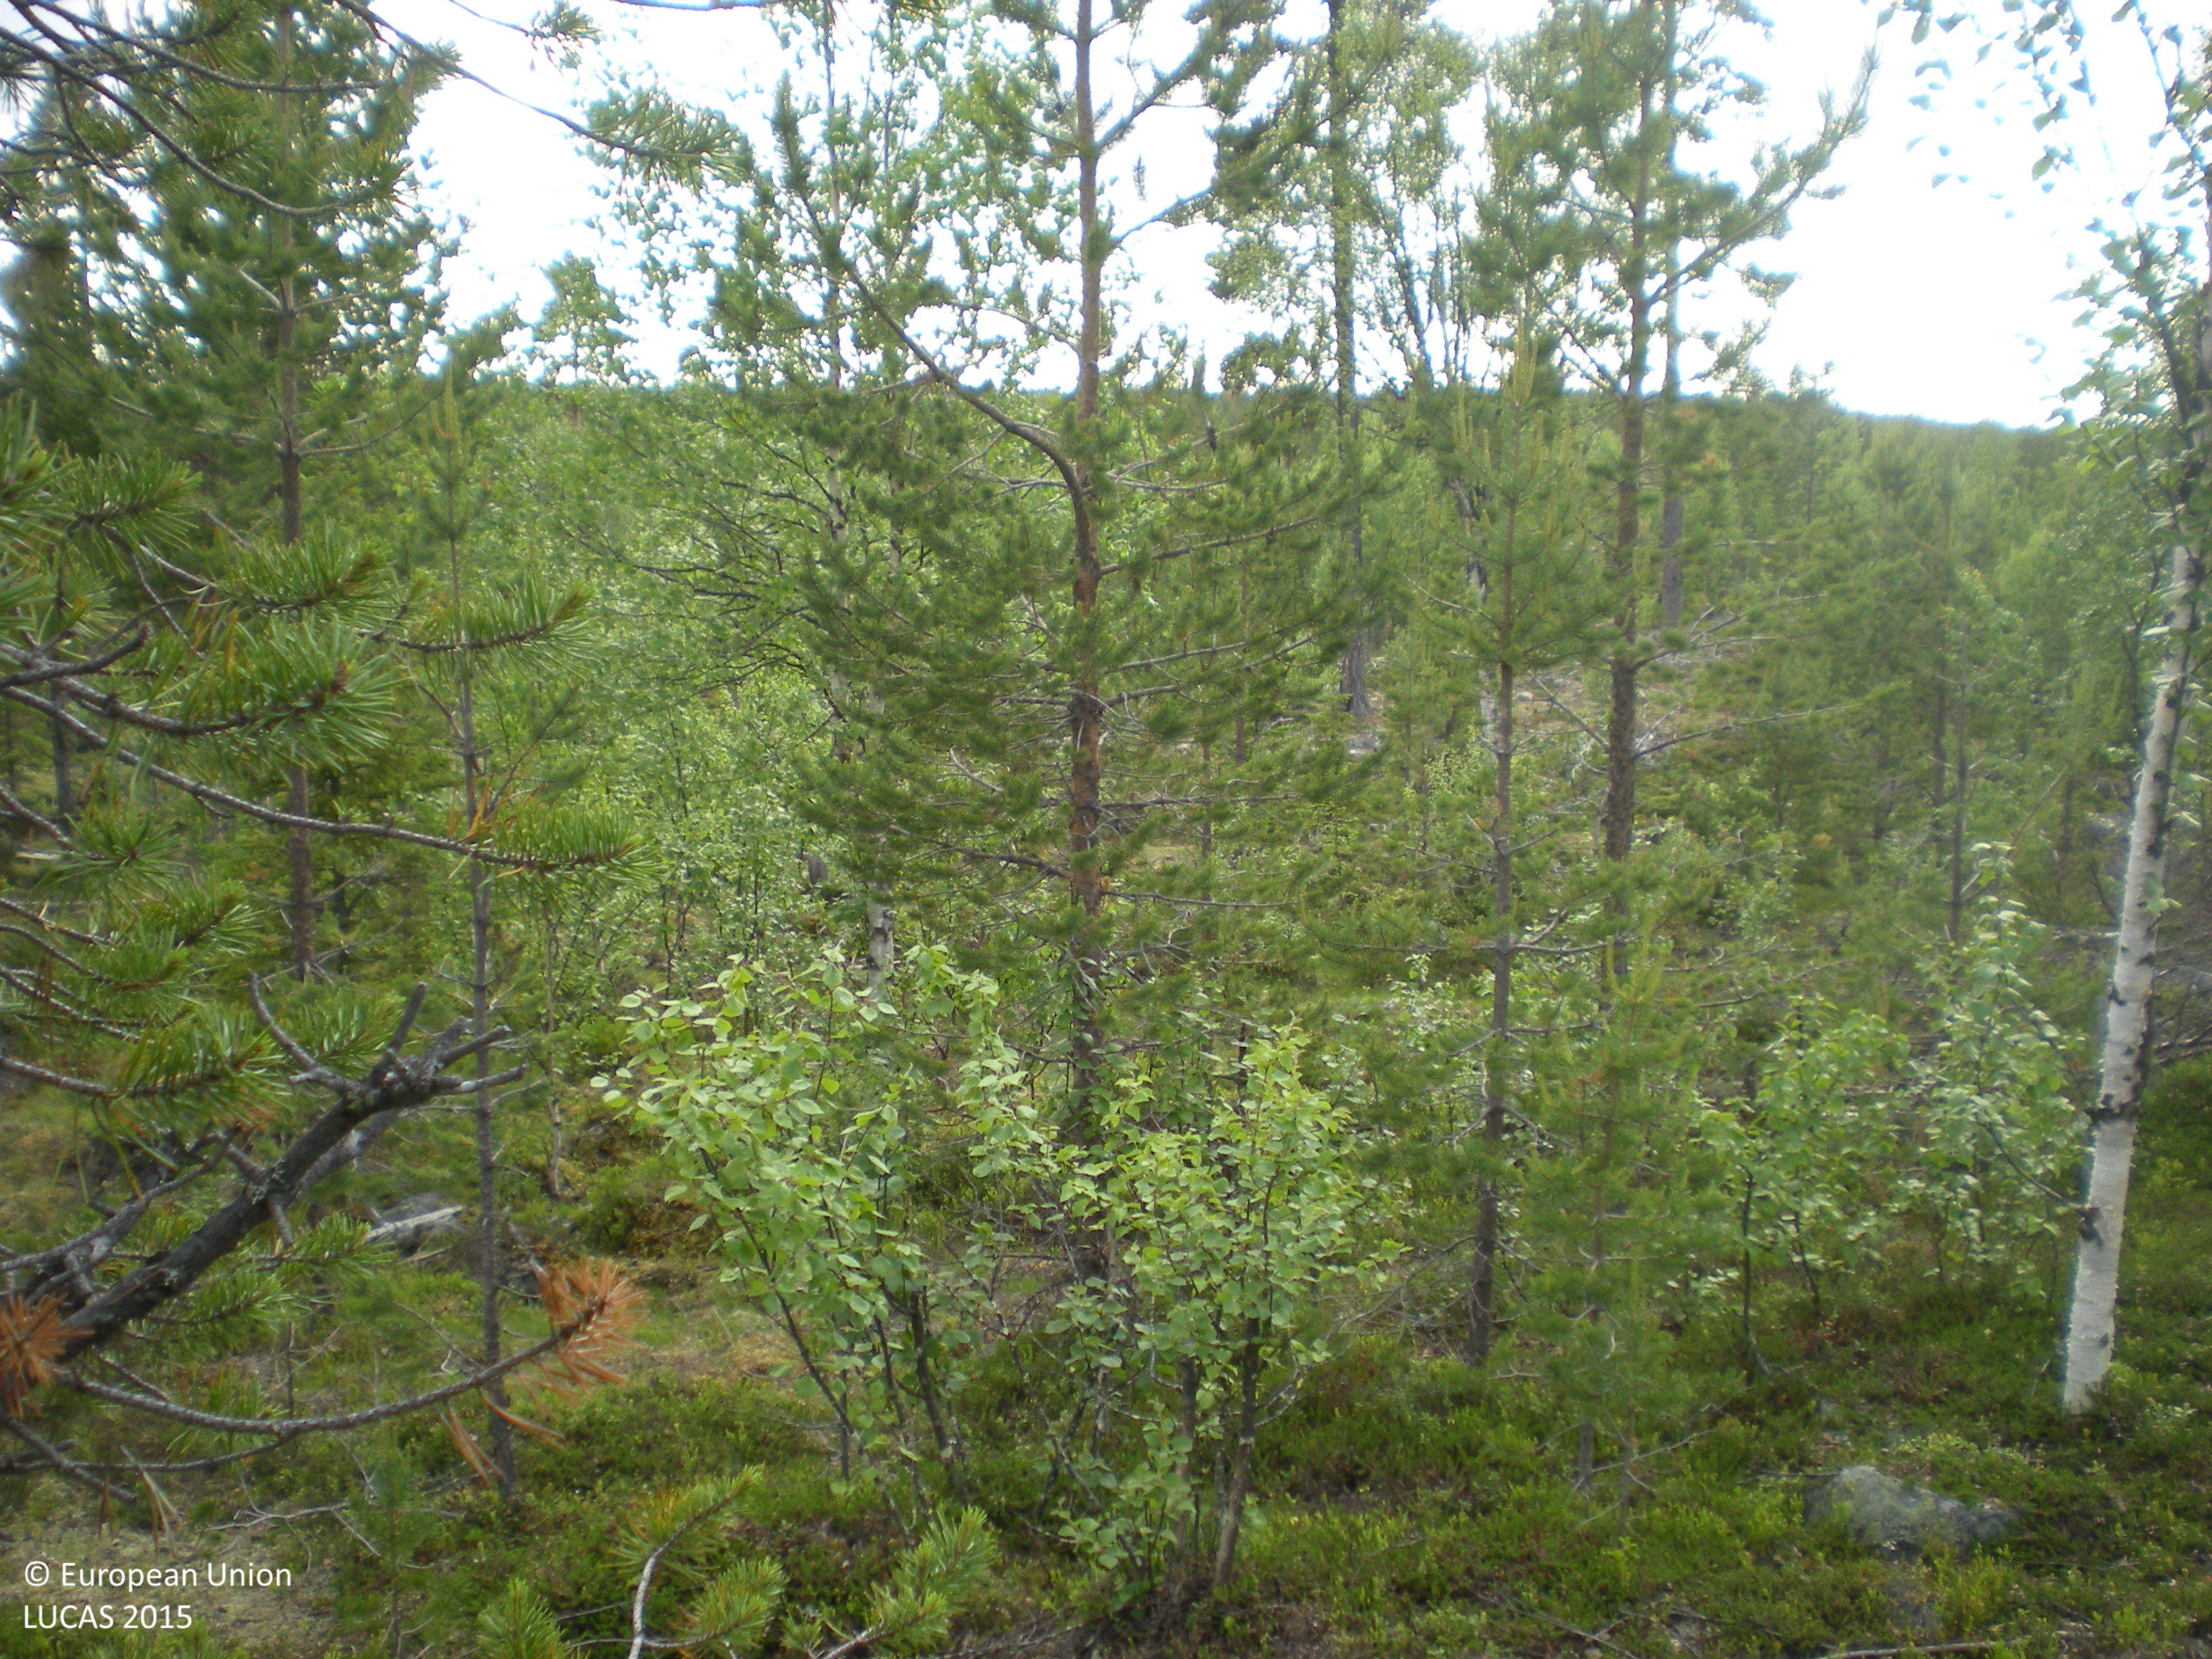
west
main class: Woodland
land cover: Other mixed woodland
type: boreal forest
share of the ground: 50 - 75 %
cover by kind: coniferous forest trees 40 %, shrubs 30 %, broadleaved forest trees 15 %, lichens and mosses 10 %, consolidated bare surface 5 %
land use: Forestry
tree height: > 5 m
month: July
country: SE
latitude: 65.6563
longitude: 17.0686
